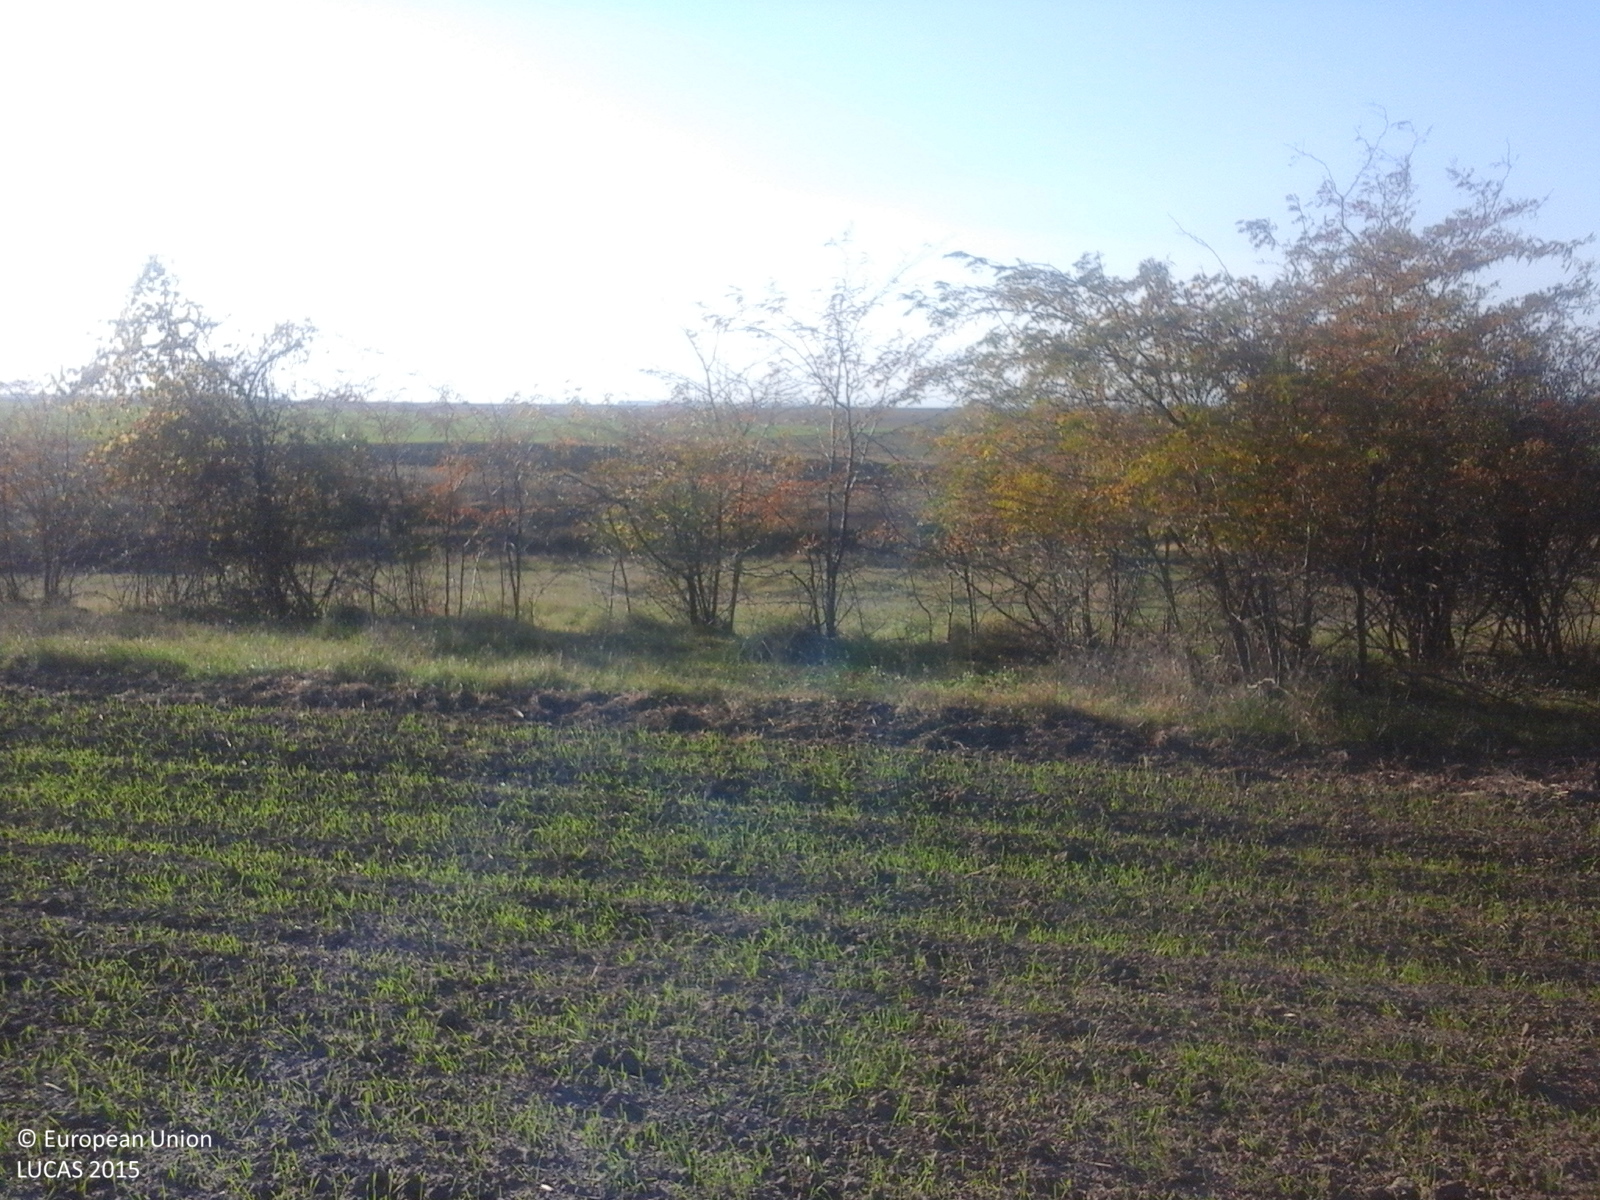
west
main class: Cropland
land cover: Common wheat
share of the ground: 10 - 25 %
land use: Agriculture (excluding fallow land and kitchen gardens)
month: October
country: RO
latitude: 45.2706
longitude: 27.3409
